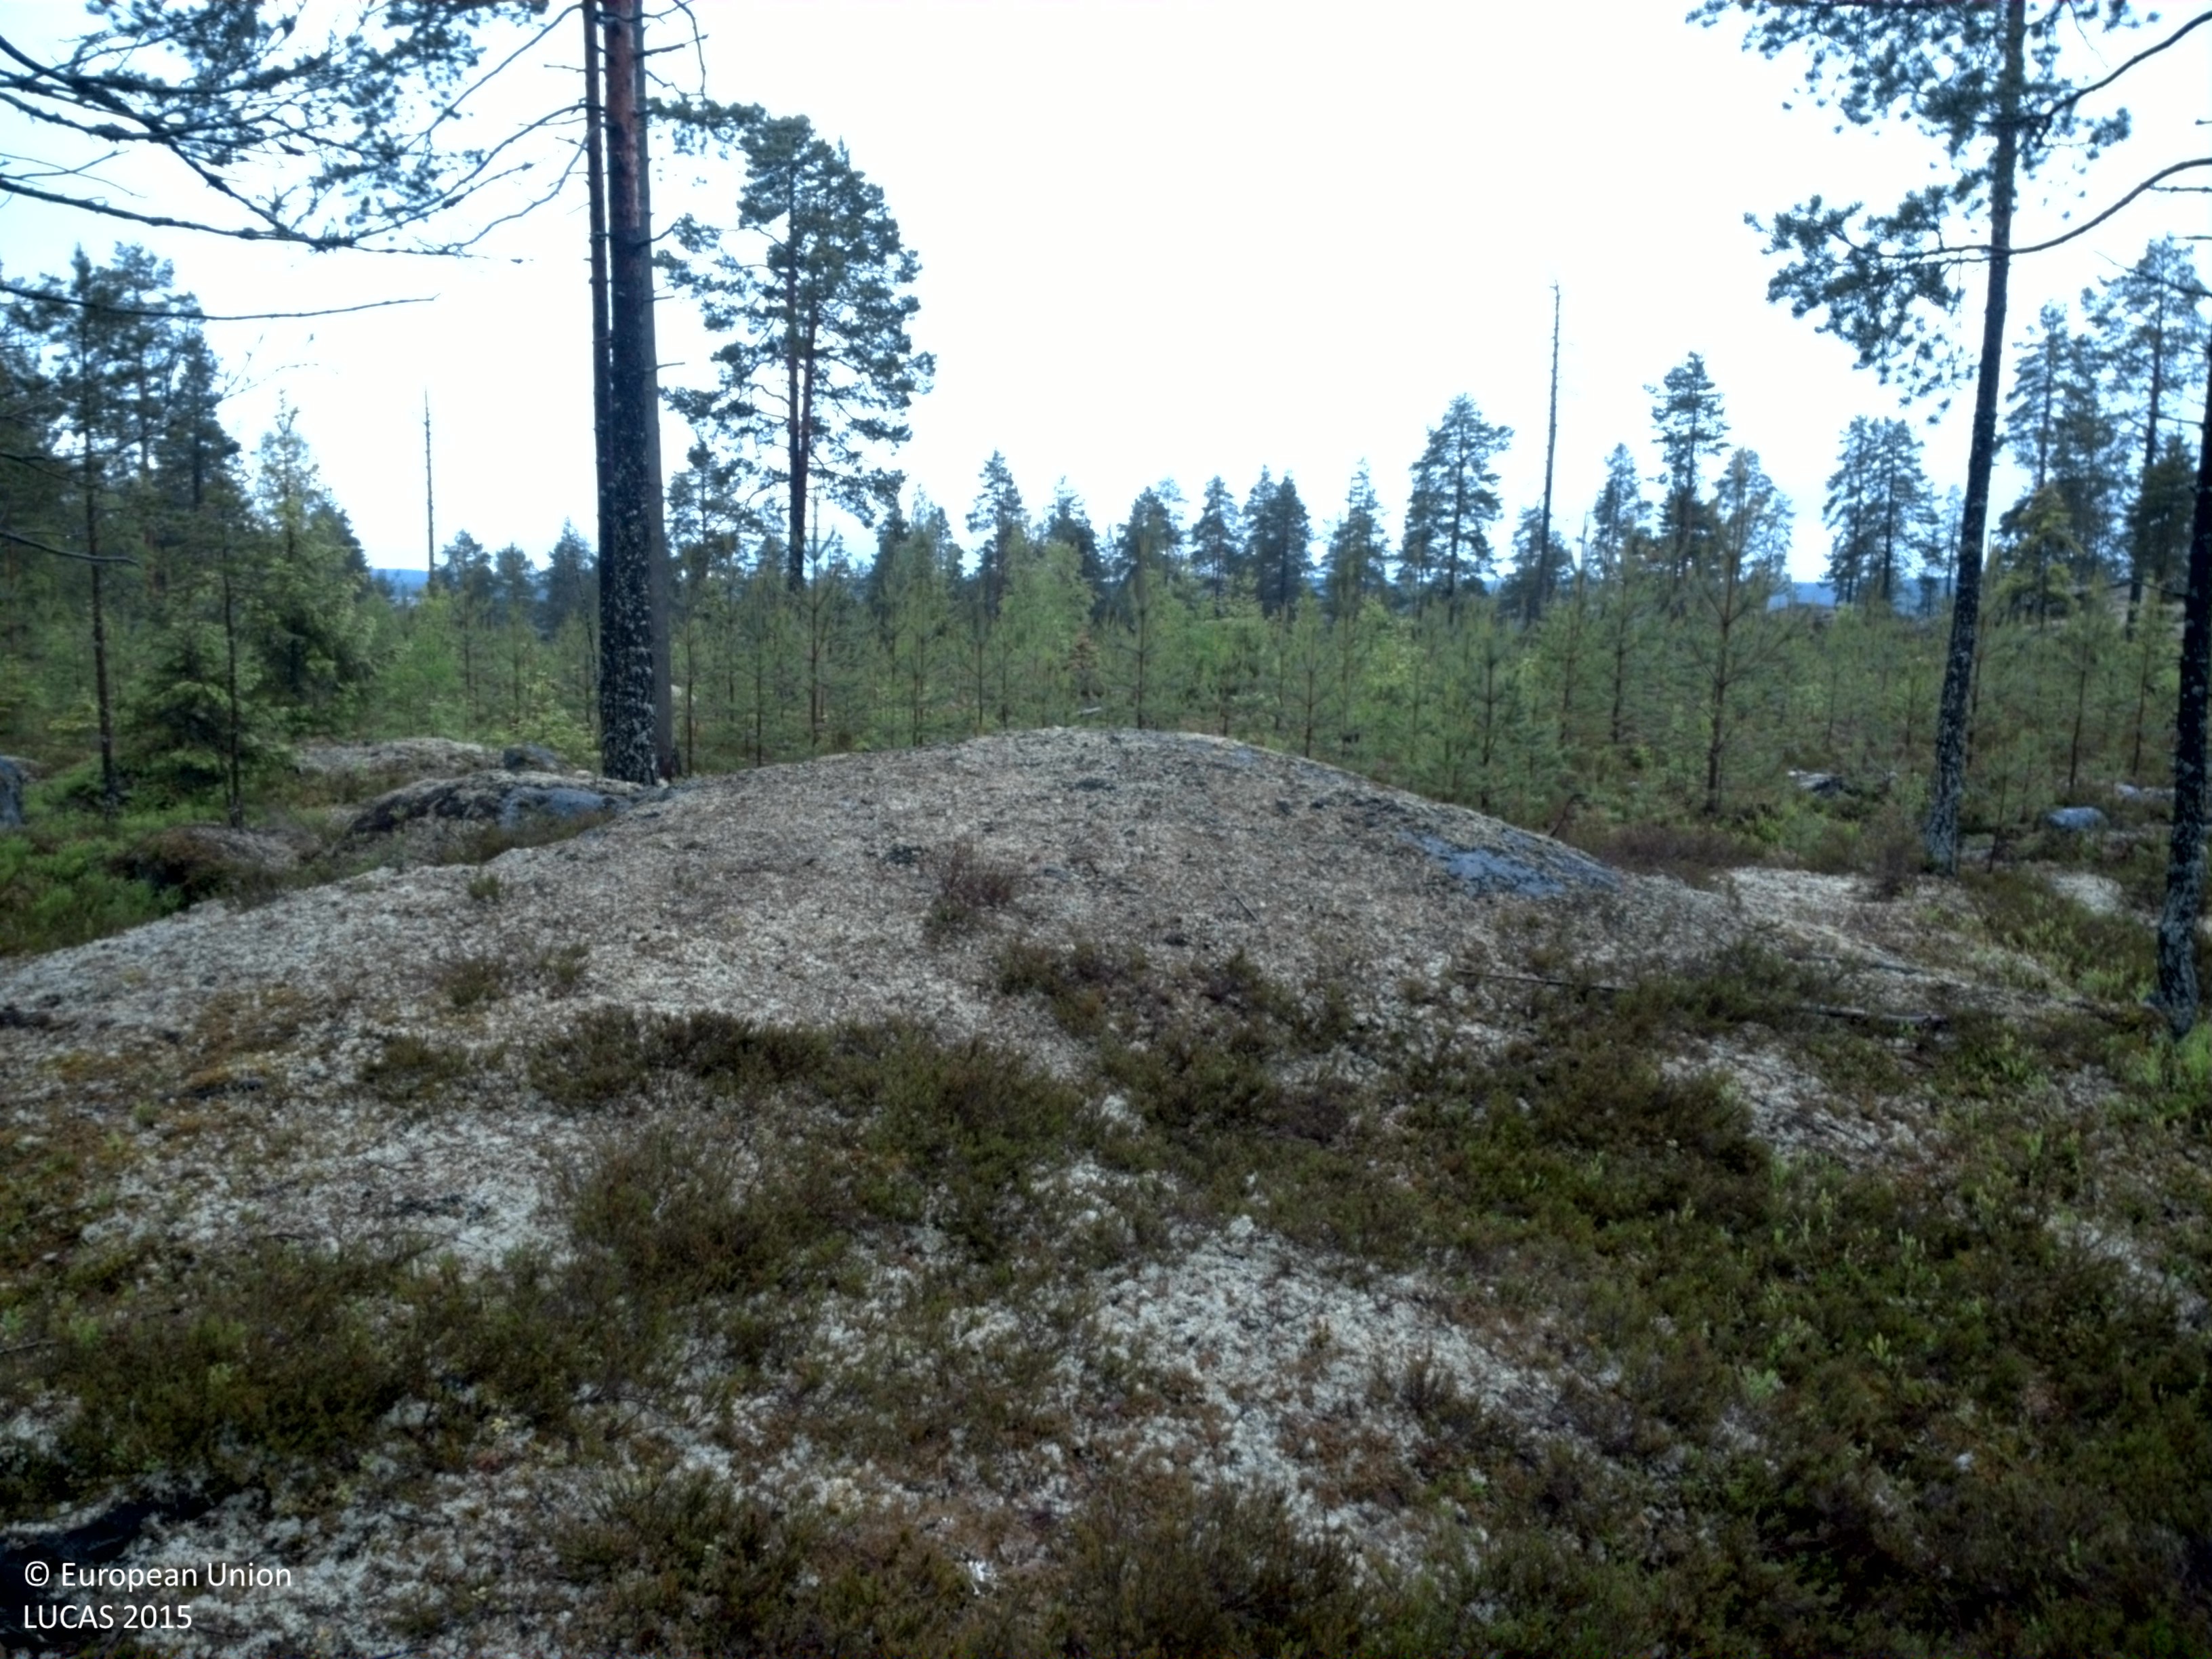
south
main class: Woodland
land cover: Pine dominated coniferous woodland
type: boreal forest
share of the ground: 25 - 50 %
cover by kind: shrubs 40 %, coniferous forest trees 35 %, lichens and mosses 20 %, consolidated bare surface 5 %
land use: Forestry
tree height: > 5 m
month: June
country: SE
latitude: 64.3155
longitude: 20.8797
